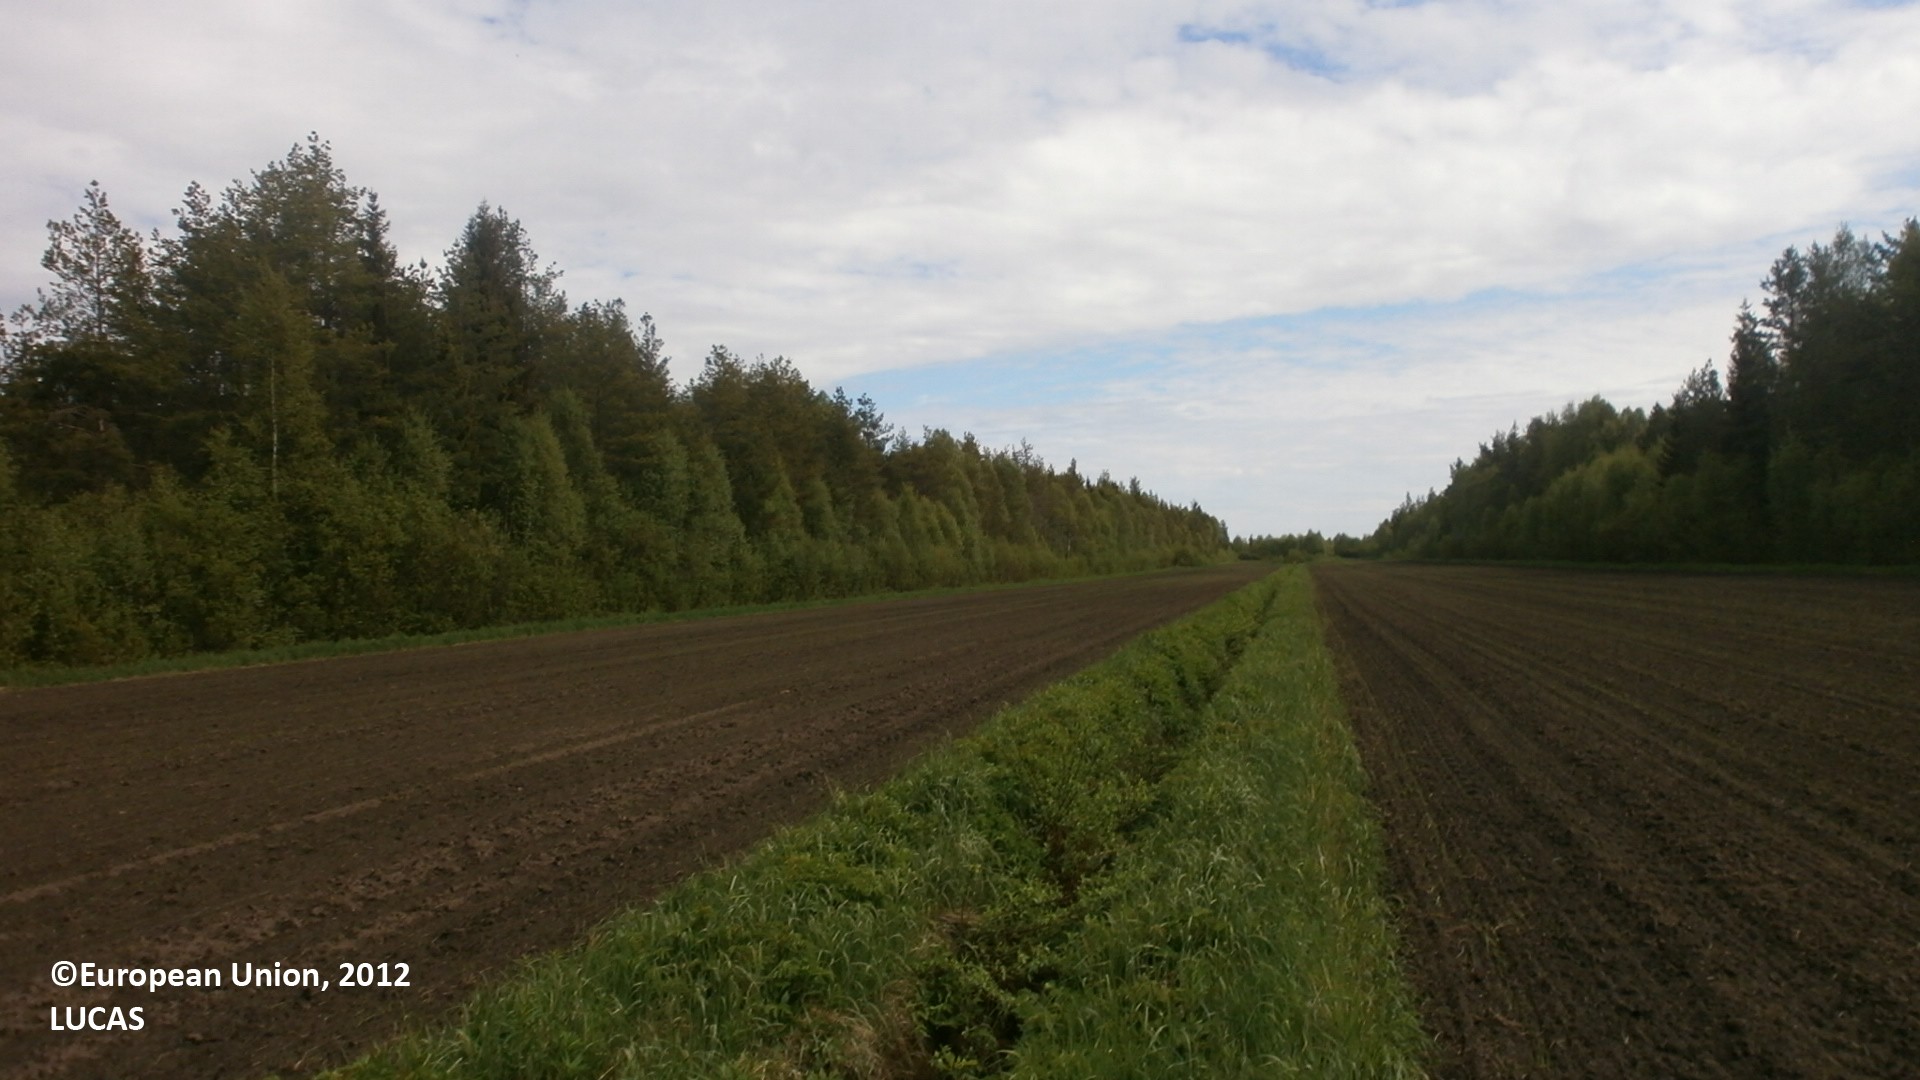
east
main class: Cropland
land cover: Barley
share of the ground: < 10 %
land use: Agriculture (excluding fallow land and kitchen gardens)
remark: Tilled/Sowed
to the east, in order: Grass margins; Ditches and canals; Grass margins; Barley; Grass margins; Ditches and canals; Other mixed woodland; Ditches and canals; Other mixed woodland; Ditches and canals; Other mixed woodland; Spruce dominated mixed woodland; Ditches and canals; Spruce dominated mixed woodland
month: June
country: FI
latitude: 64.4838
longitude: 25.0822
